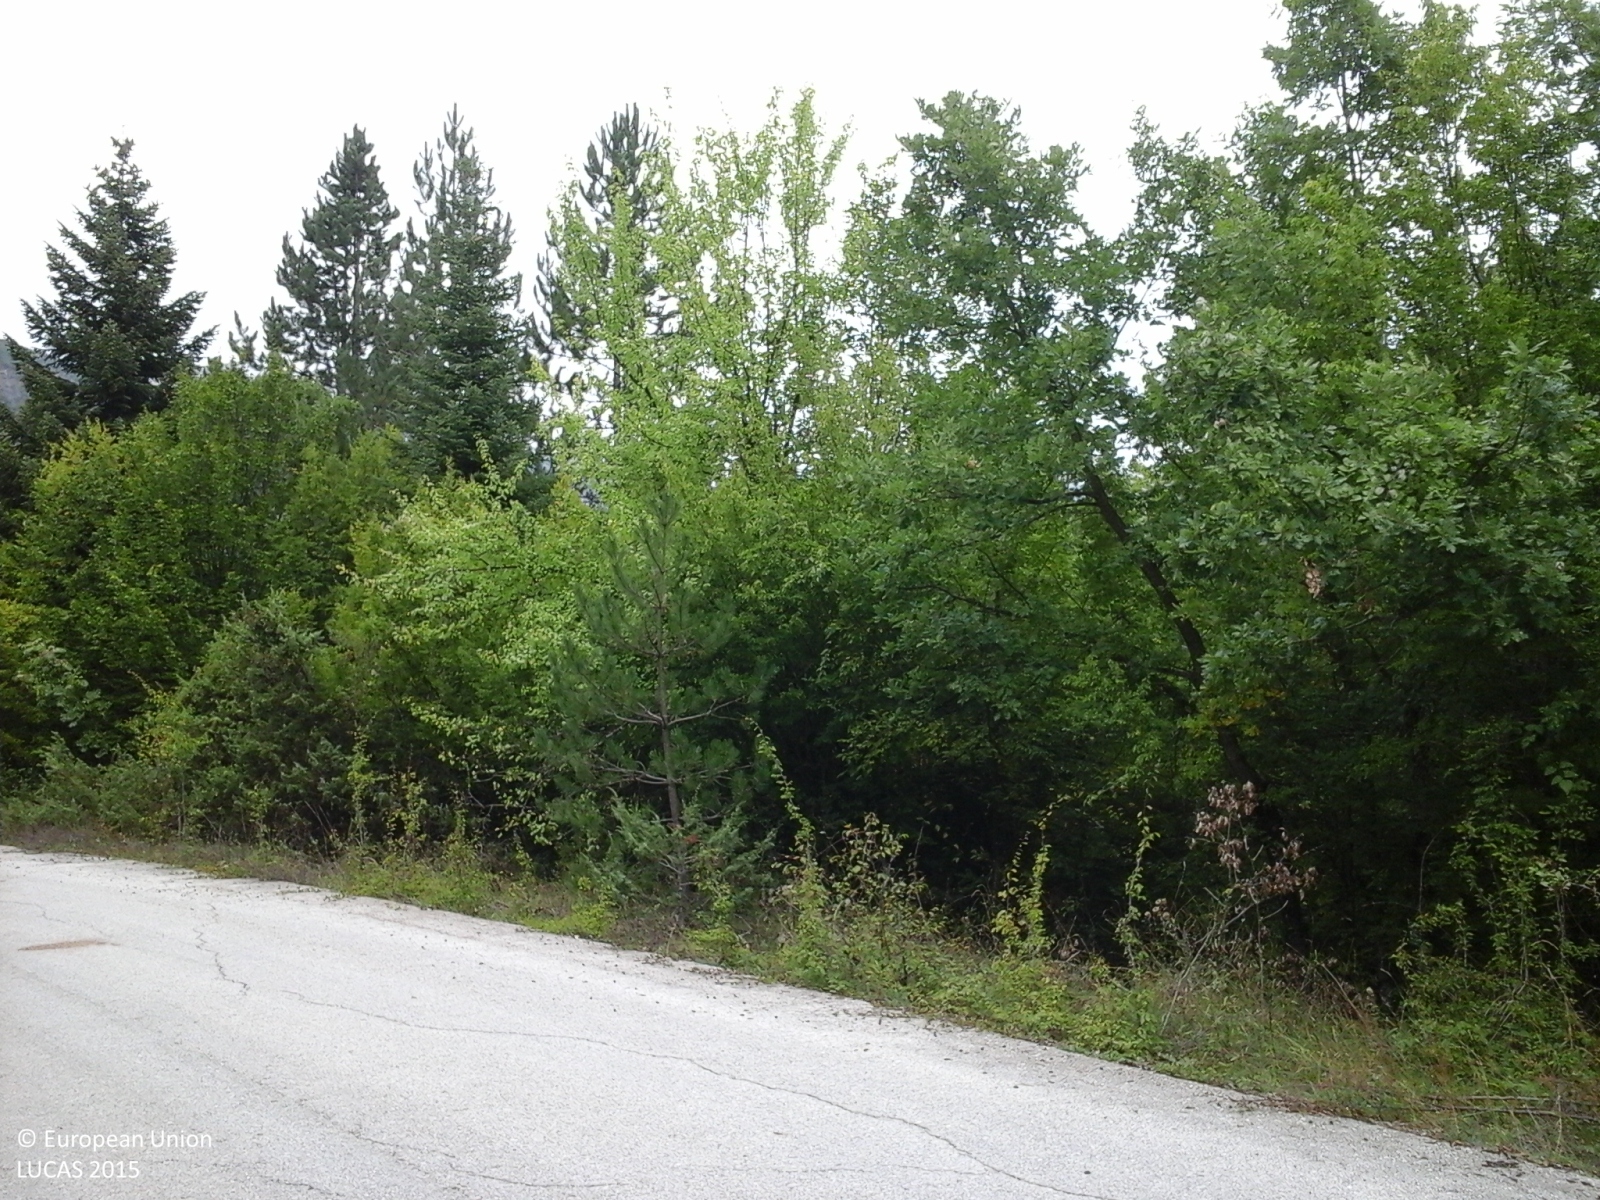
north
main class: Woodland
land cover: Broadleaved woodland
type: thermophilous deciduous forest
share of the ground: > 75 %
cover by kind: broadleaved forest trees 90 %, shrubs 5 %, herbaceous plants 5 %
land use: Forestry
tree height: > 5 m
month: October
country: GR
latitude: 40.2567
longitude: 20.7655
